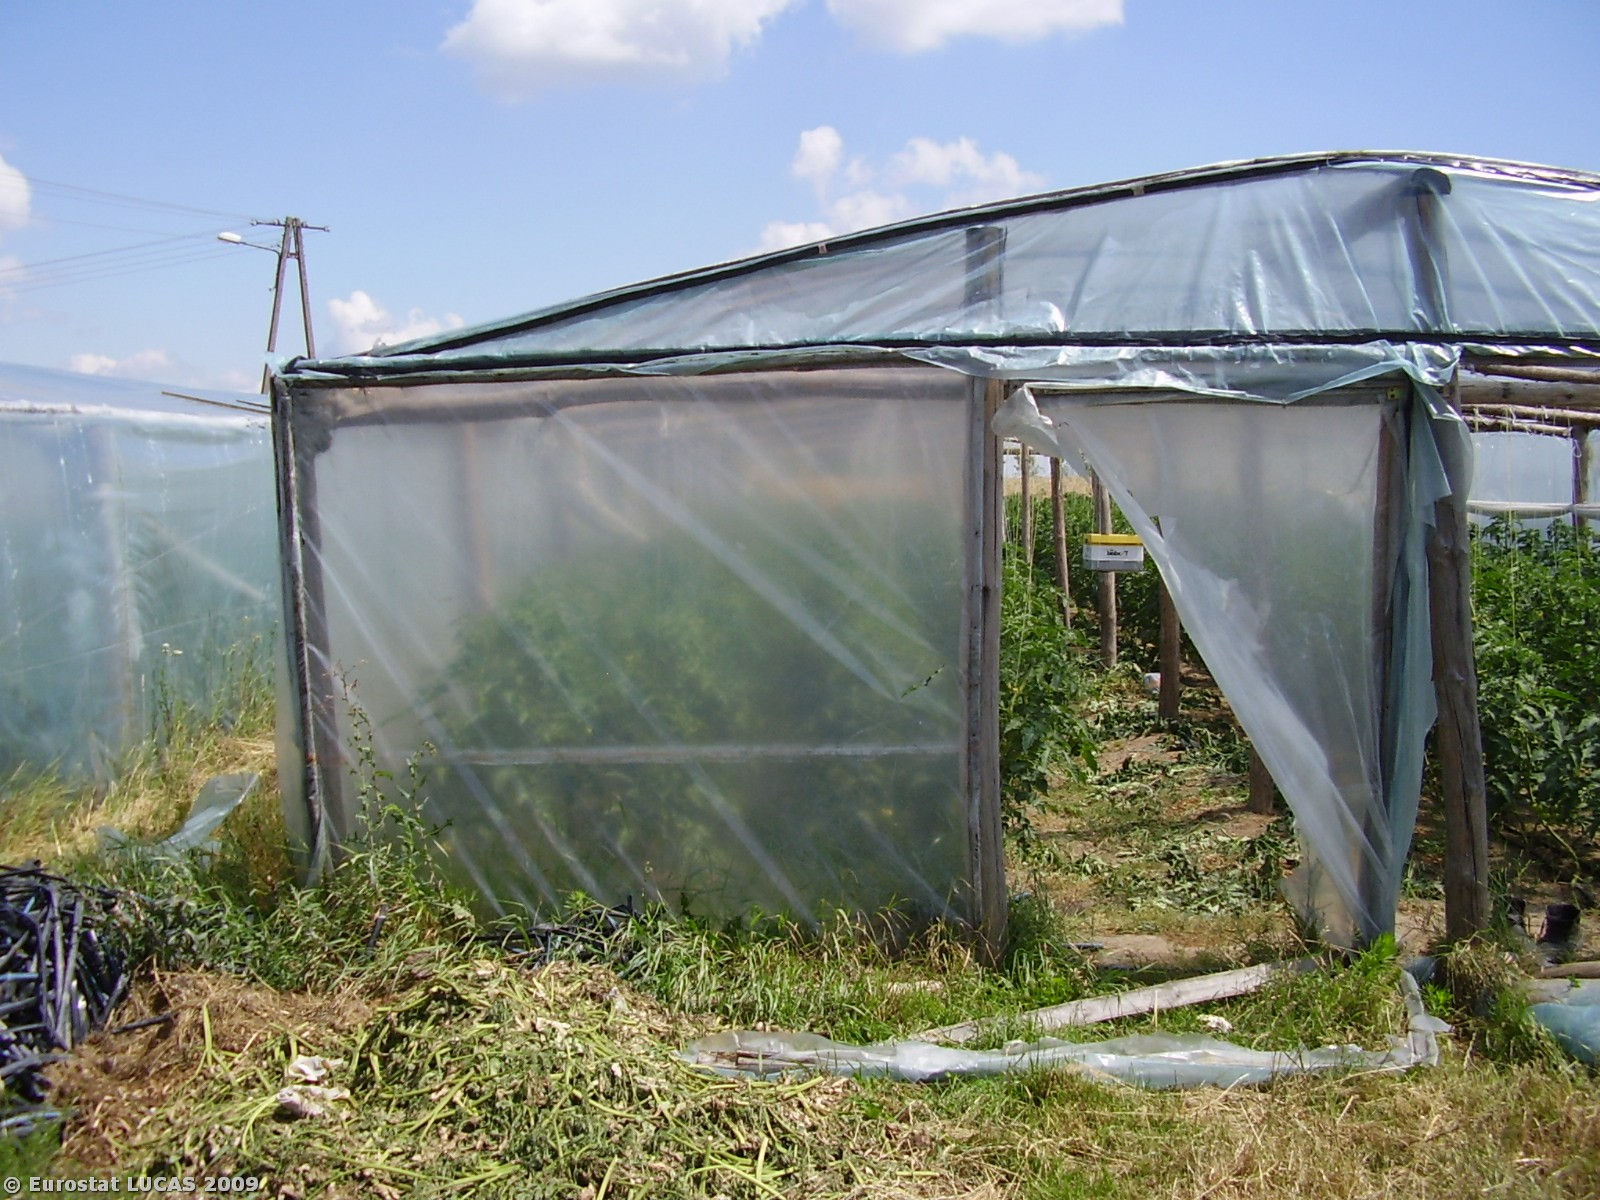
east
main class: Artificial land
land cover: Greenhouses
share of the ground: > 75 %
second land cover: Tomatoes
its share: > 75 %
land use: Agriculture (excluding fallow land and kitchen gardens)
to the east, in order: Artificial constructions in urban areas; Tomatoes; Grass margins; Triticale
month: July
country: PL
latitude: 51.9768
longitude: 16.2814
